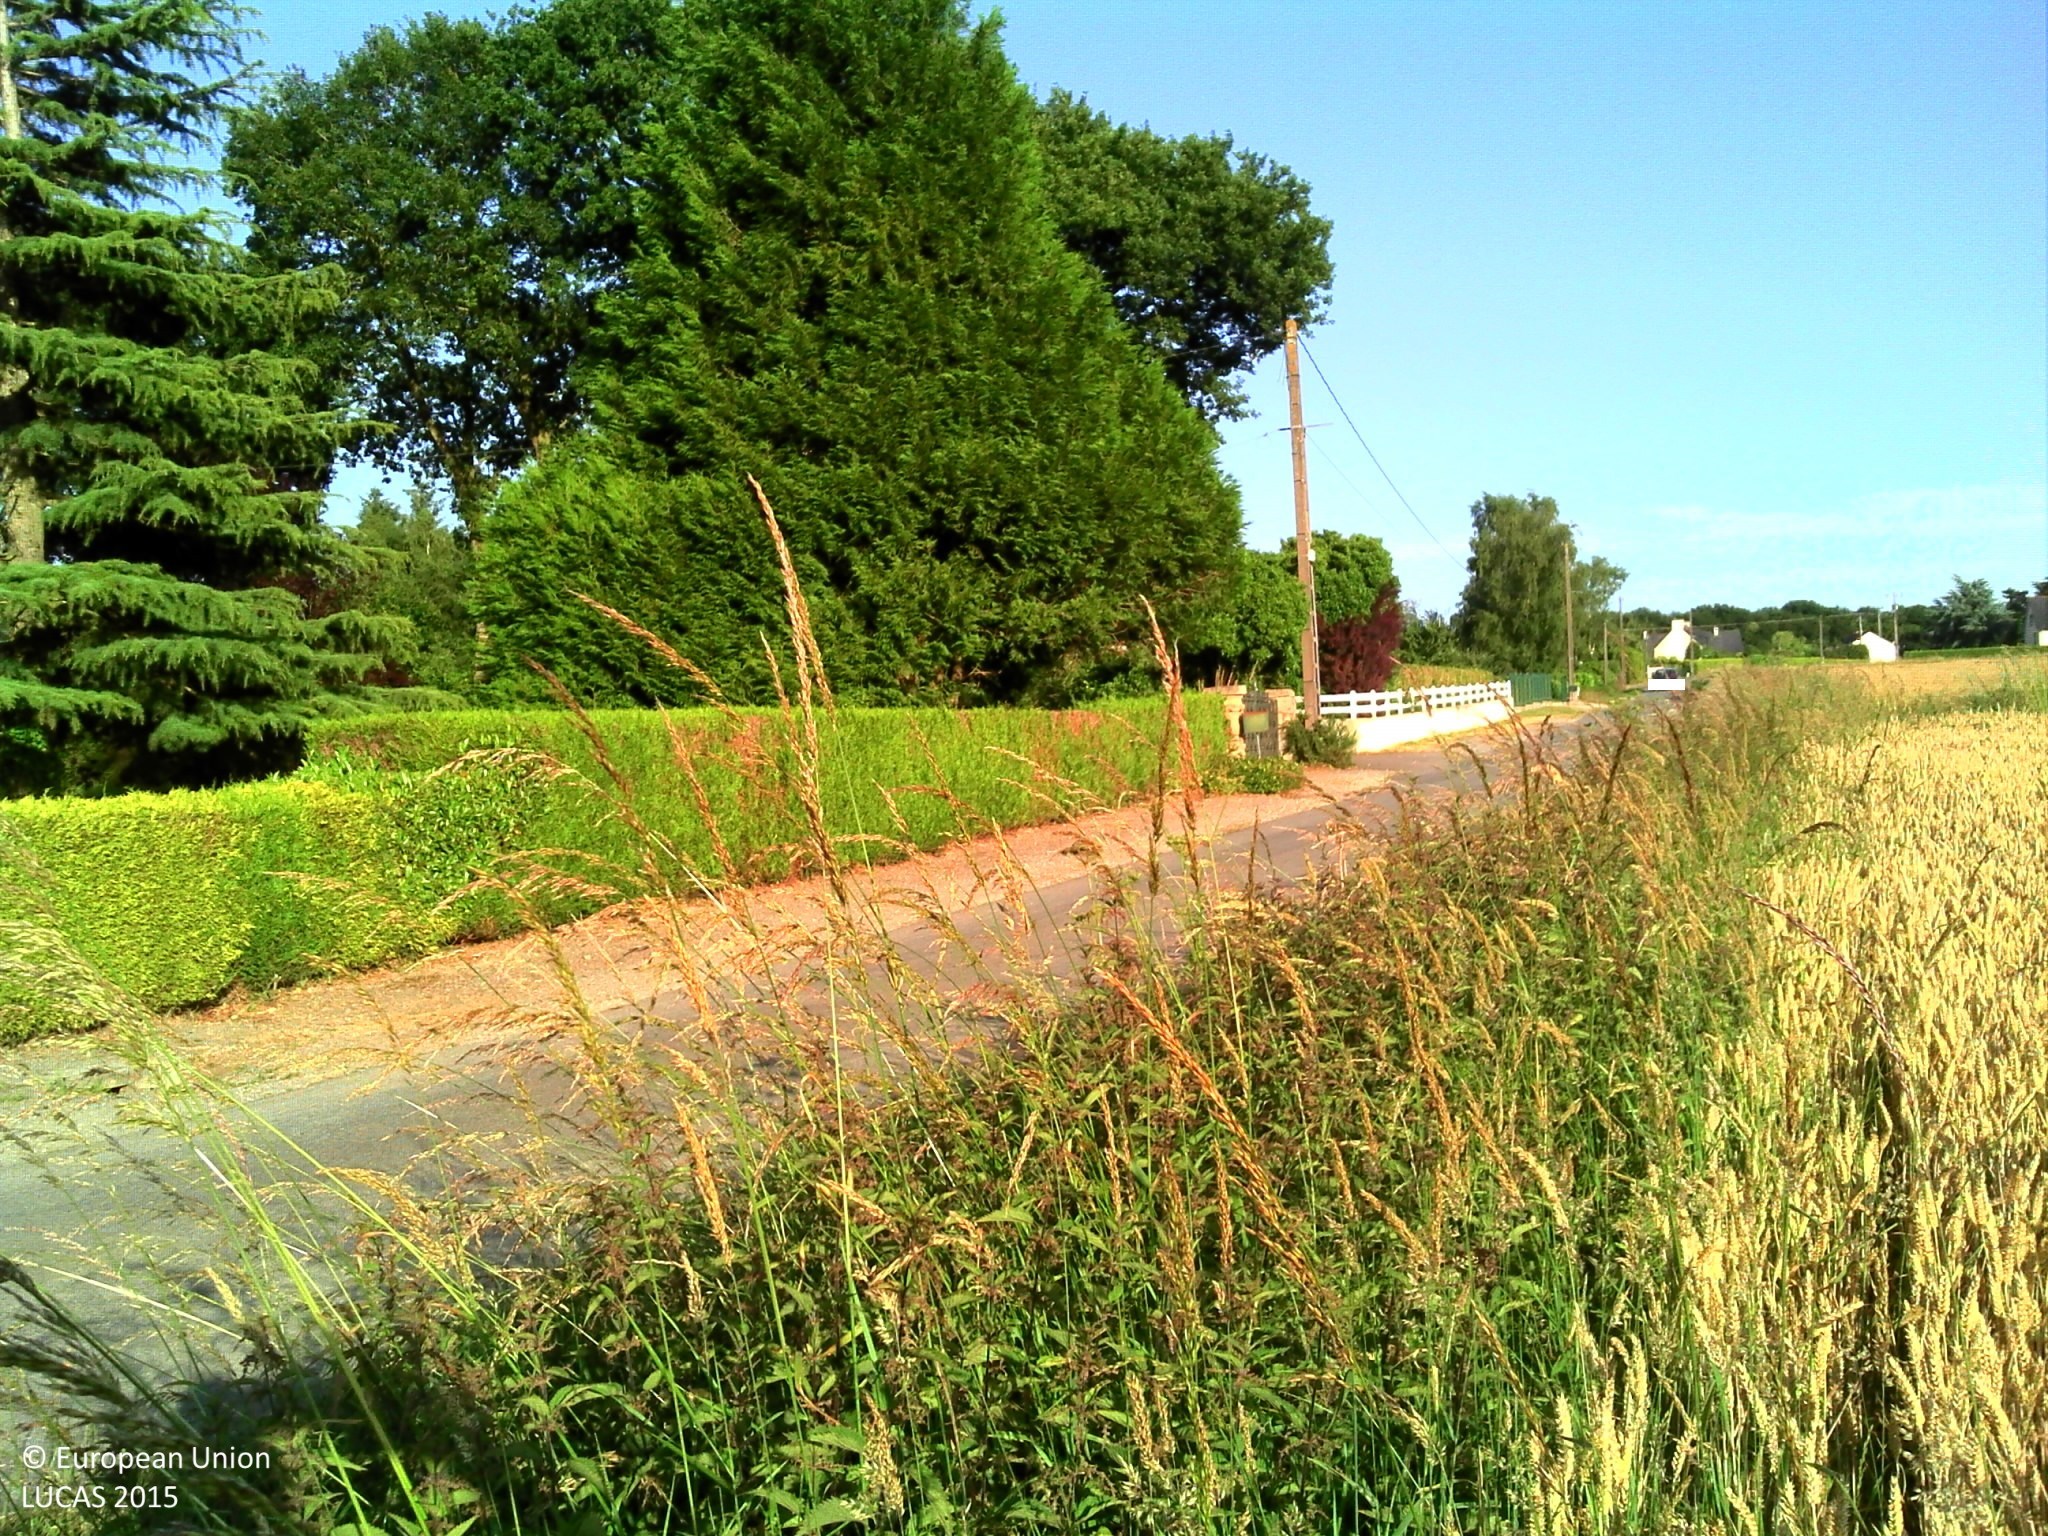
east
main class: Cropland
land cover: Common wheat
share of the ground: > 75 %
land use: Agriculture (excluding fallow land and kitchen gardens)
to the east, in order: Common wheat; Artificial constructions in urban areas; Rape and turnip rape
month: July
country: FR
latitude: 48.4337
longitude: -2.2079
